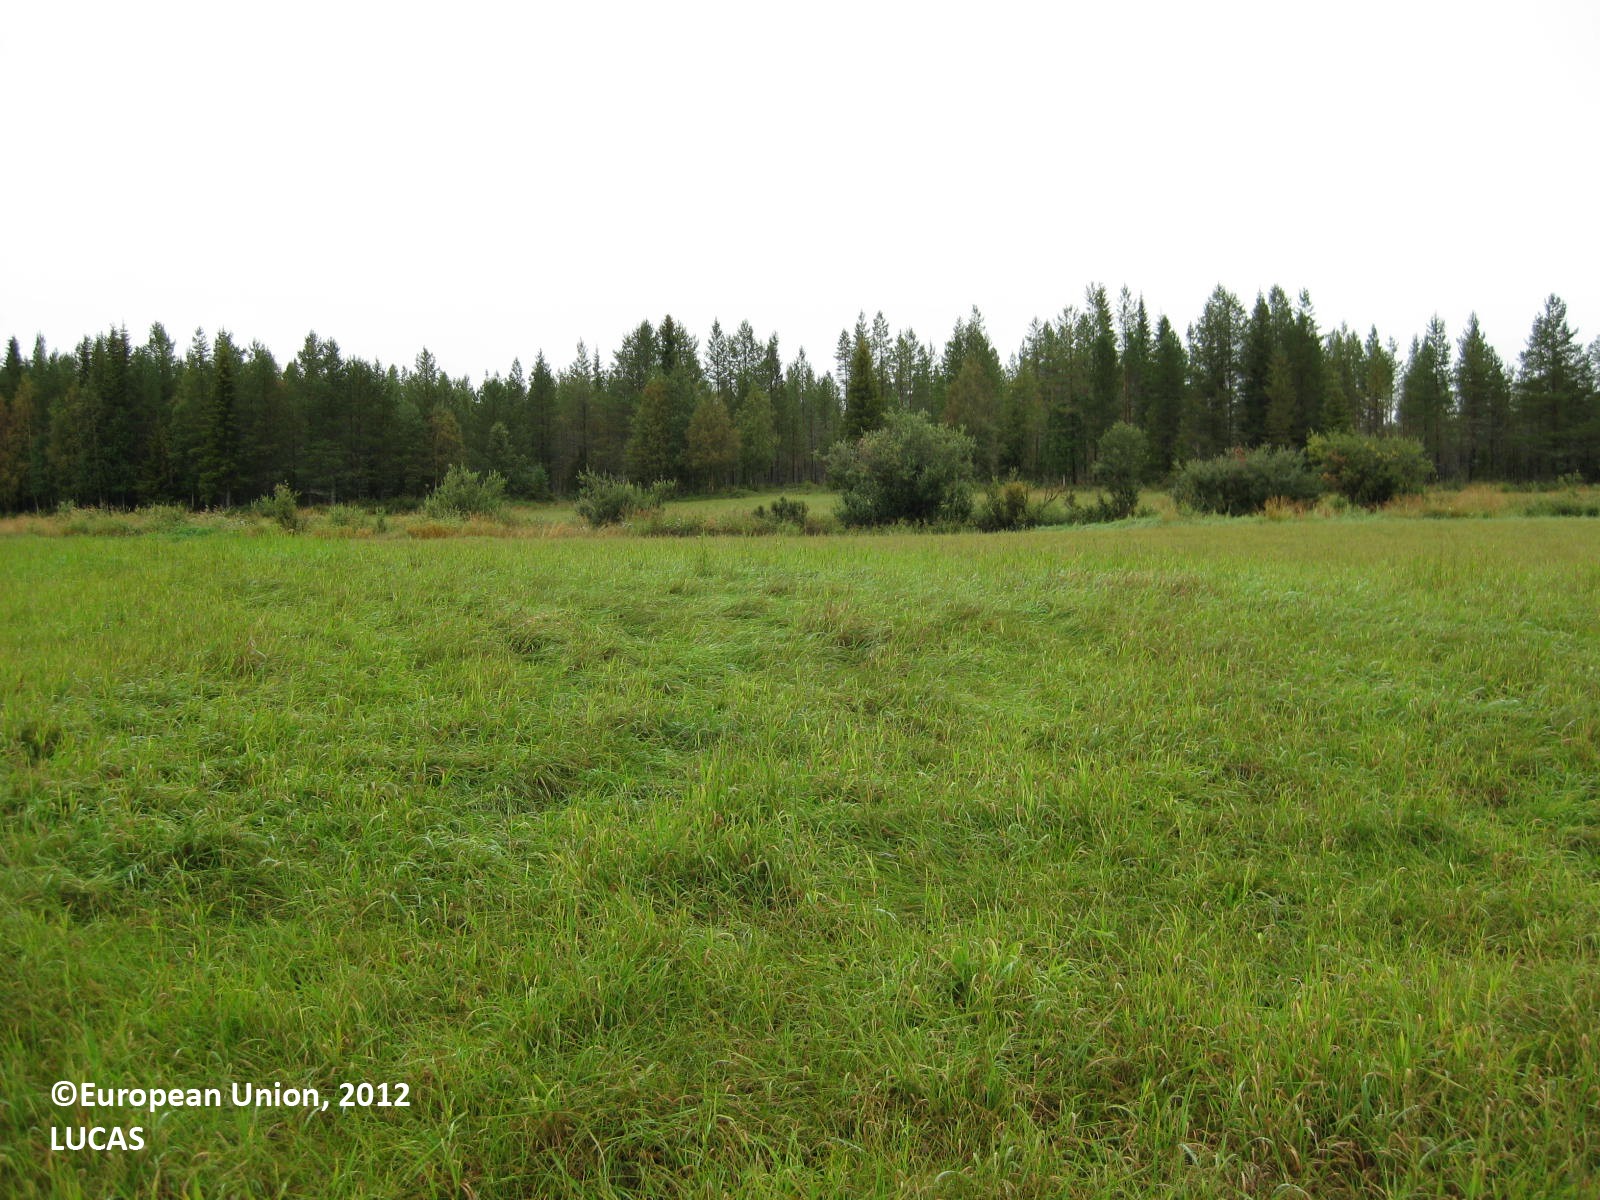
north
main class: Grassland
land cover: Grassland without tree/shrub cover
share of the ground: > 75 %
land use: Agriculture (excluding fallow land and kitchen gardens)
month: August
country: FI
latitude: 66.0293
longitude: 28.6206
